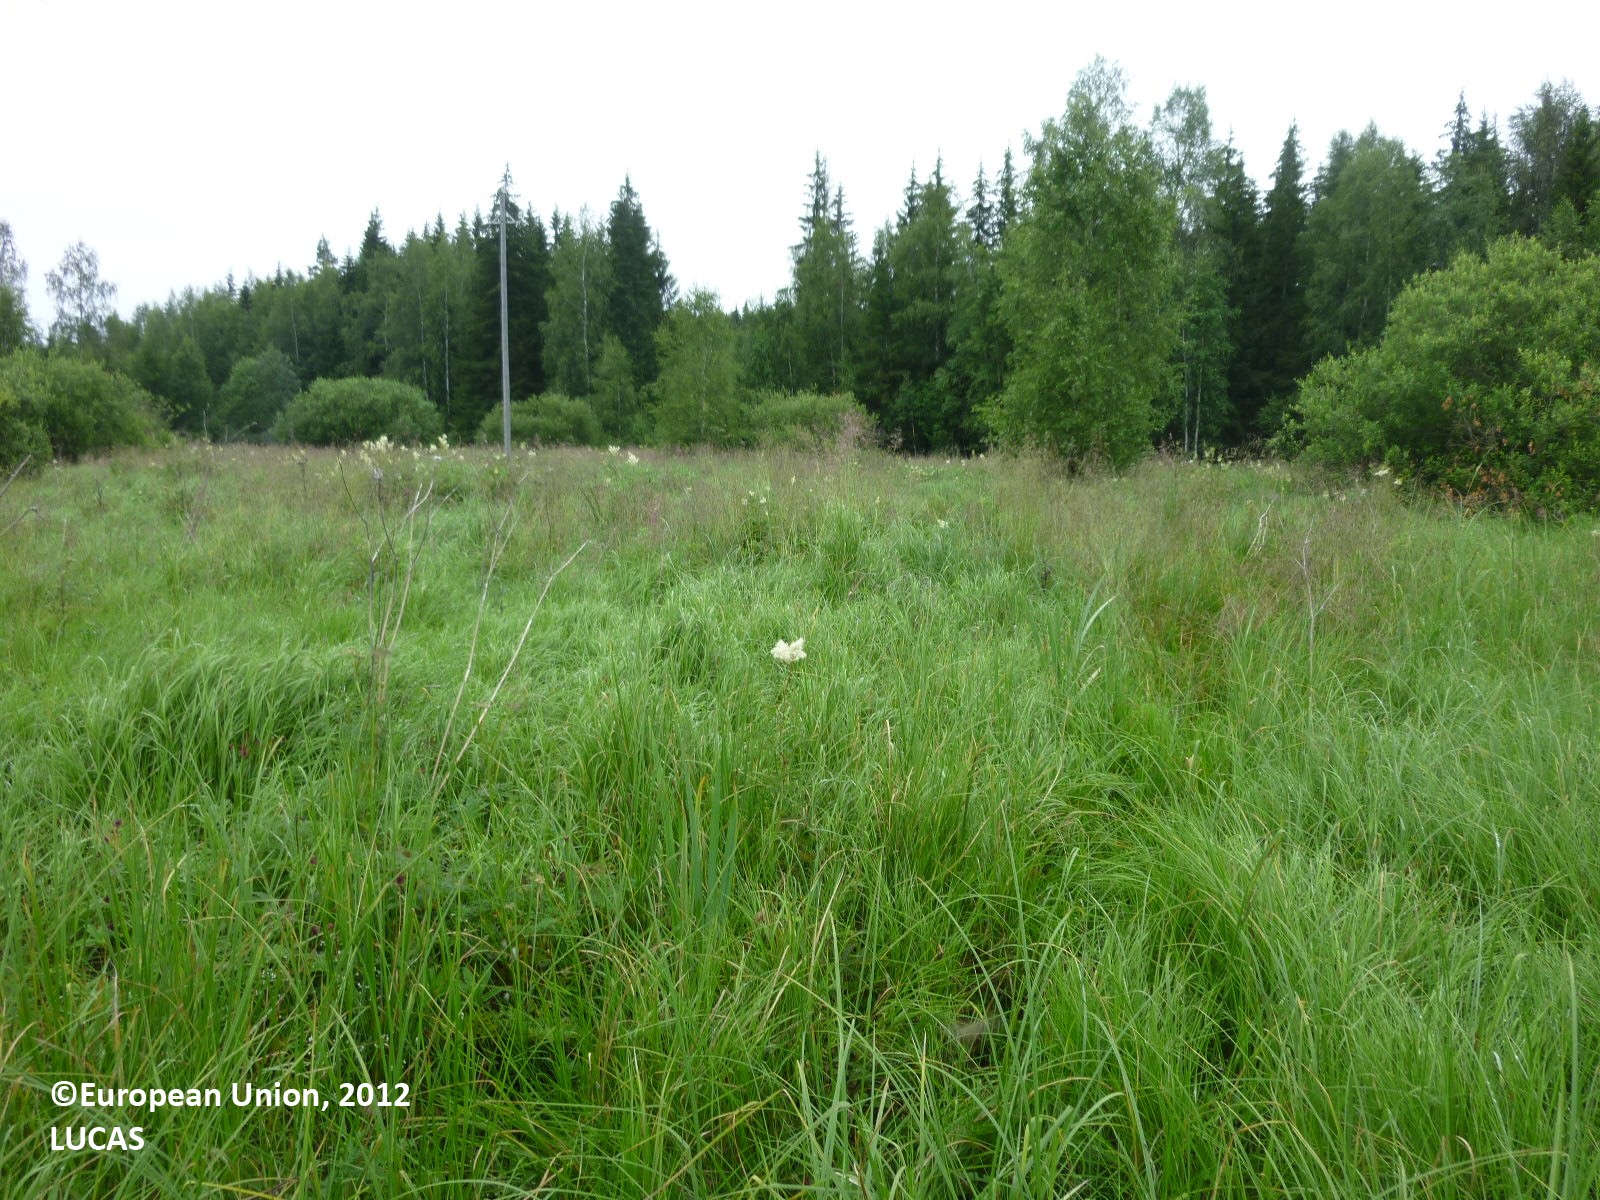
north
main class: Grassland
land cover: Grassland with sparse tree/shrub cover
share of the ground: > 75 %
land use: Fallow land
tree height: > 5 m
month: July
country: FI
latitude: 61.4210
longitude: 22.1839
